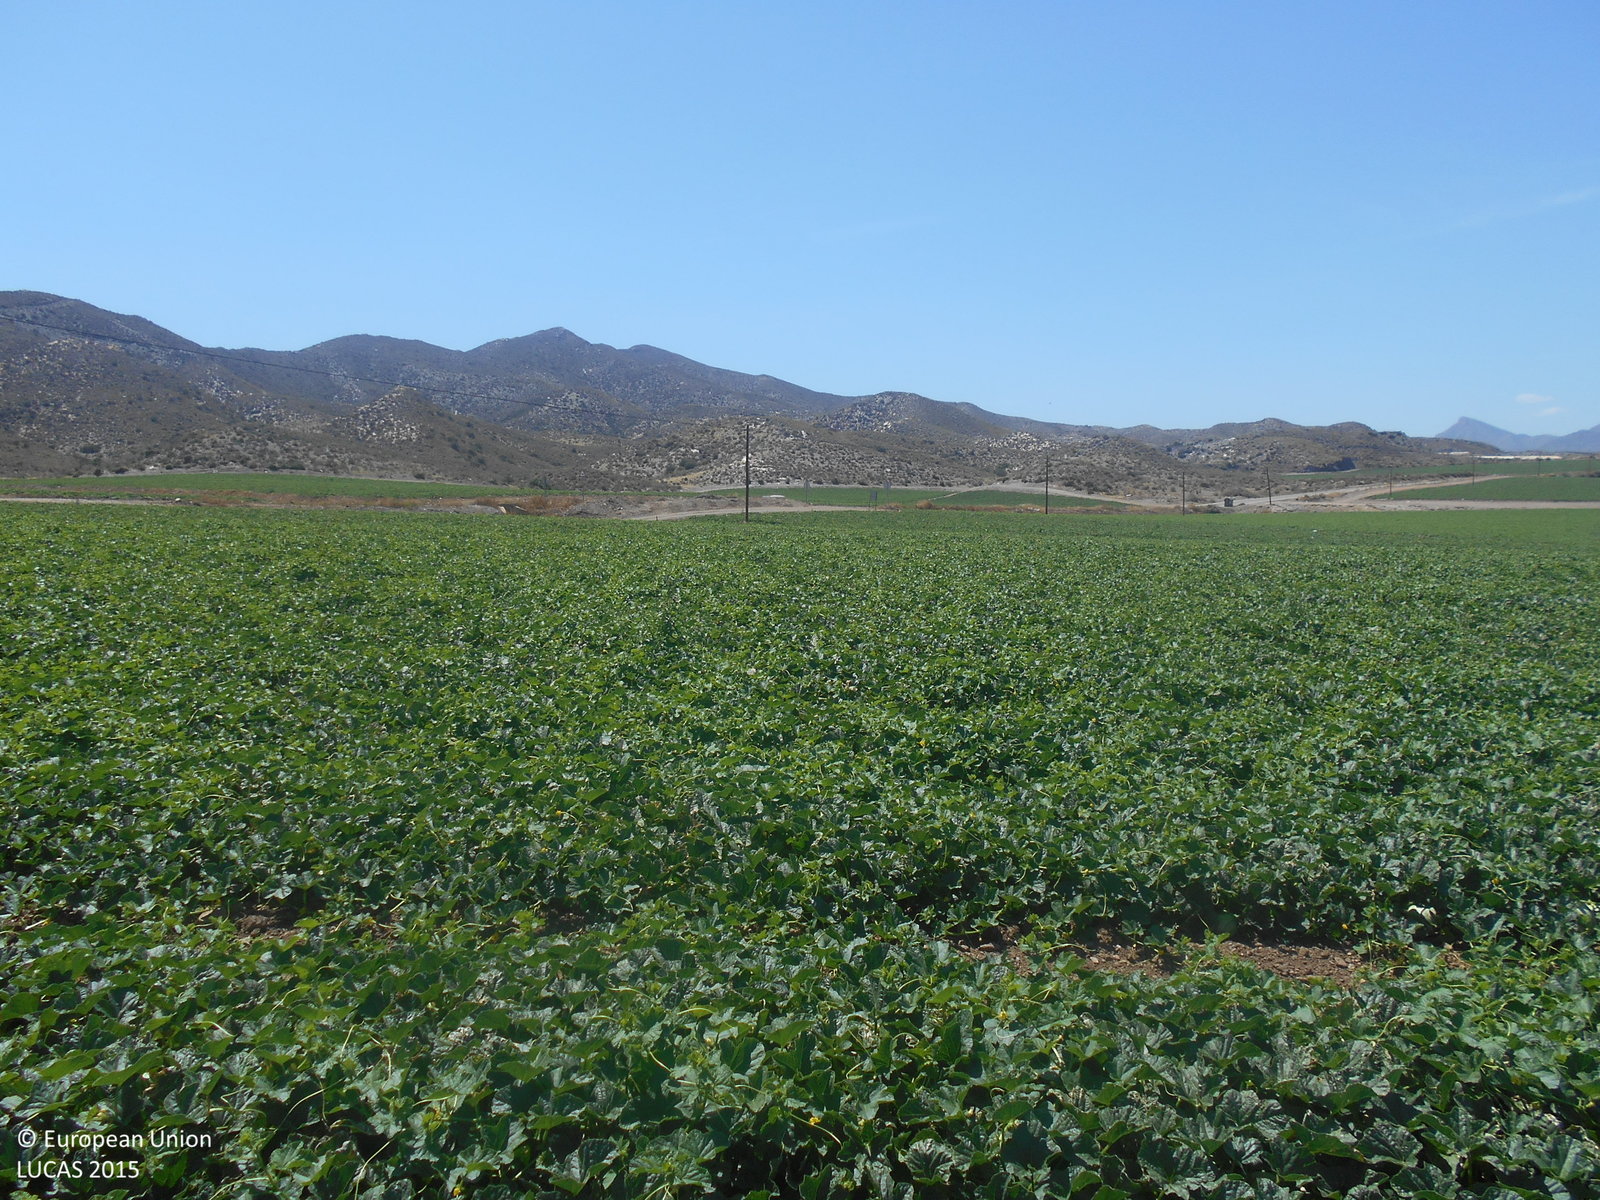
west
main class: Cropland
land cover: Other fresh vegetables
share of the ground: > 75 %
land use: Agriculture (excluding fallow land and kitchen gardens)
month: May
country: ES
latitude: 37.5150
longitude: -1.4174
